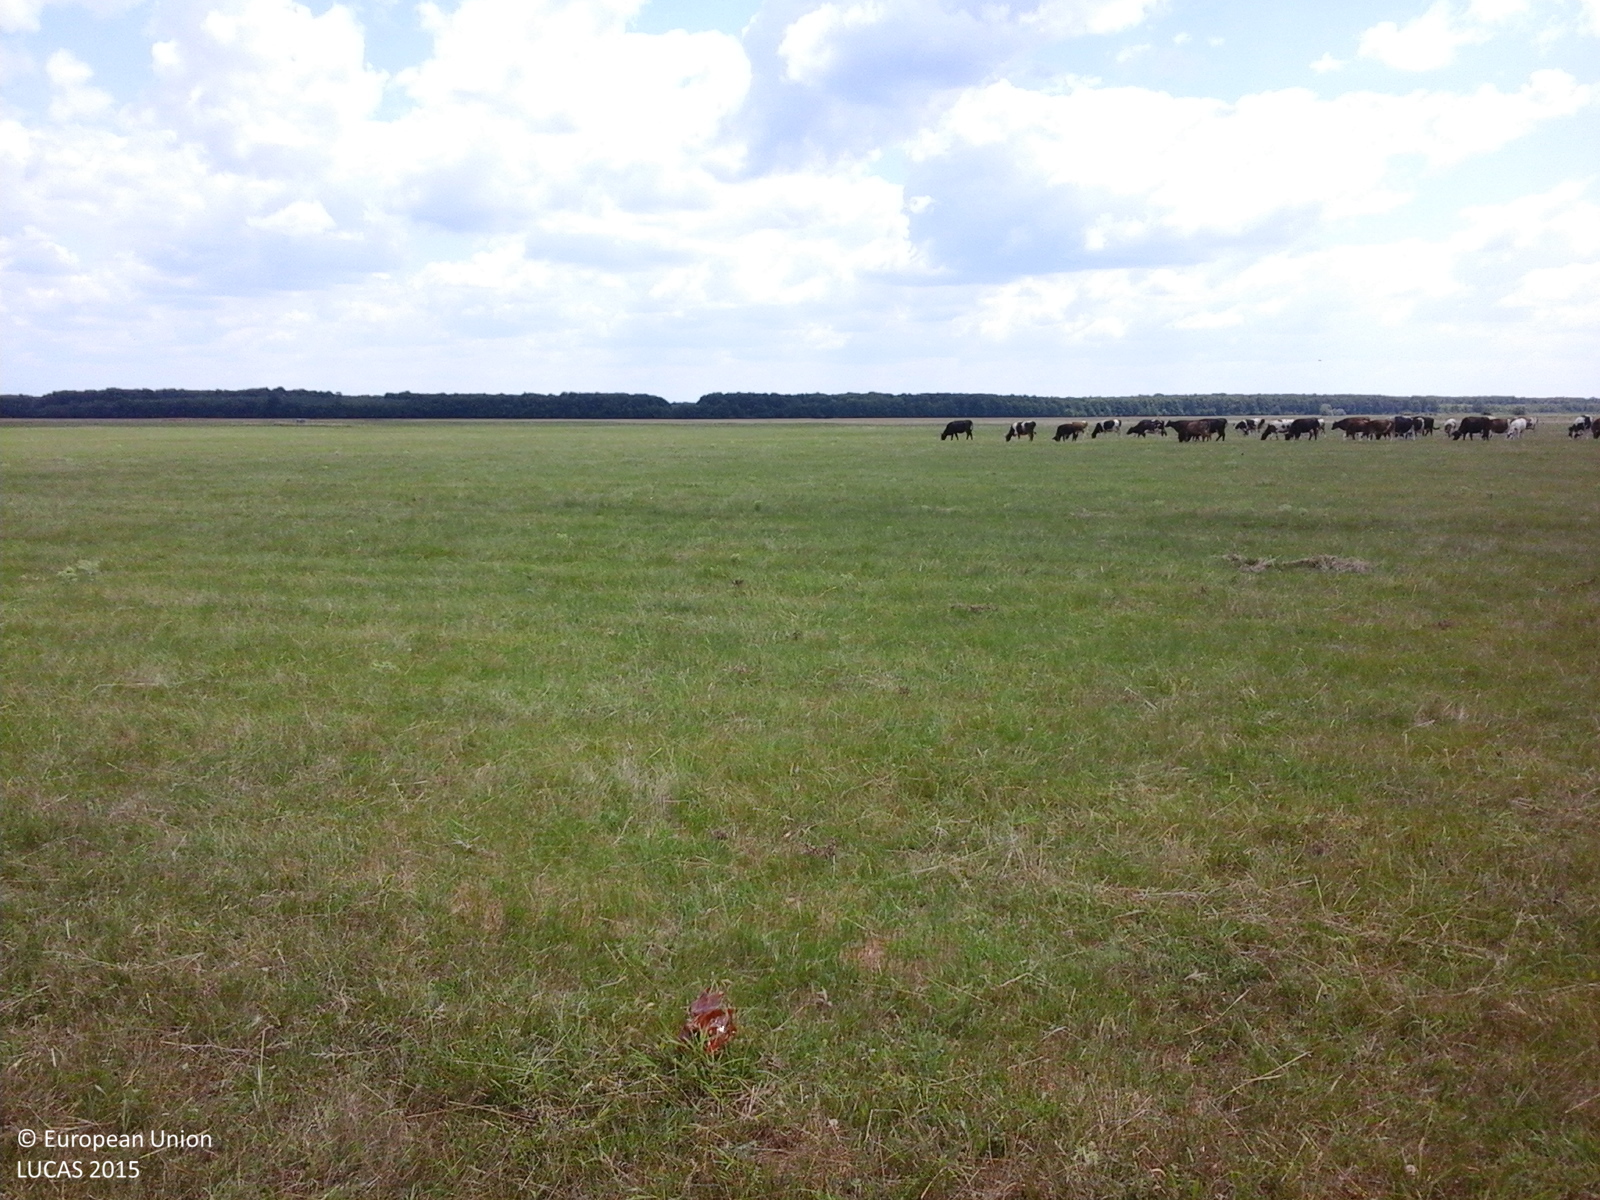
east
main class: Grassland
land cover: Grassland without tree/shrub cover
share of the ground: > 75 %
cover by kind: herbaceous plants 100 %
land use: Agriculture (excluding fallow land and kitchen gardens)
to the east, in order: Grassland without tree/shrub cover
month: July
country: RO
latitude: 44.2118
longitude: 24.8307
